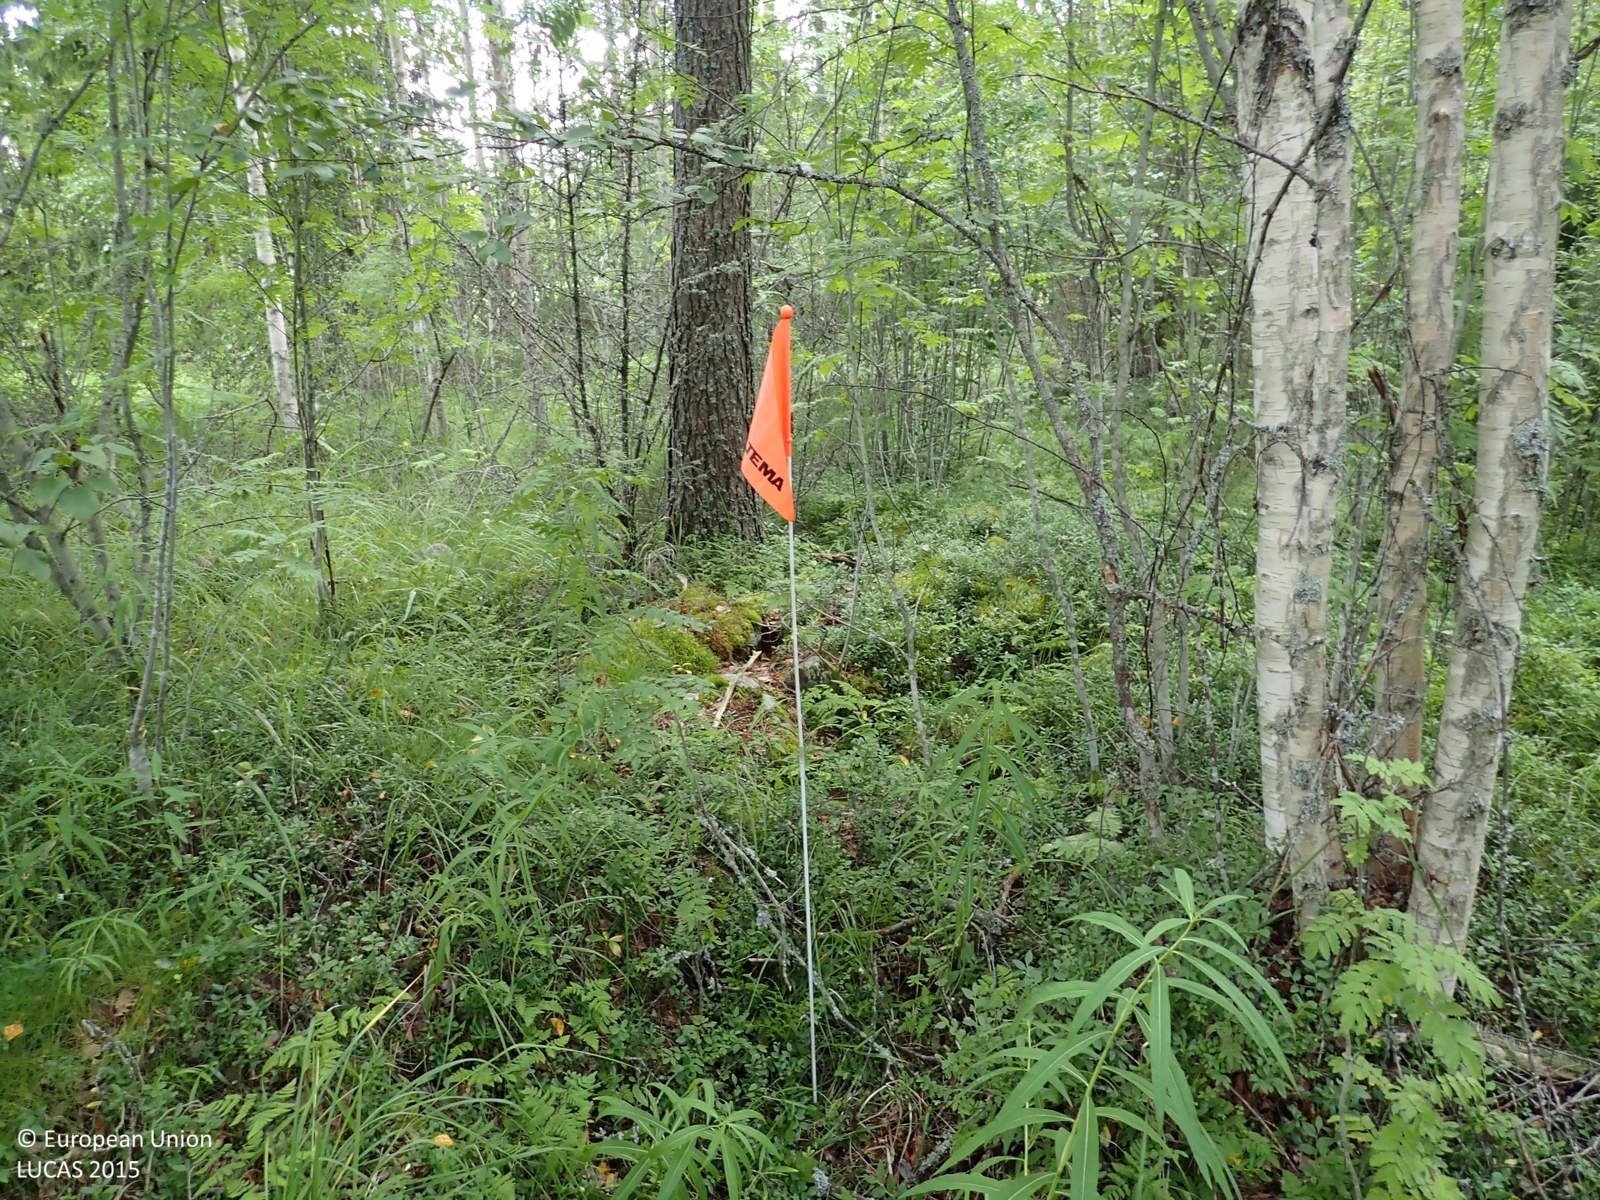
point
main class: Woodland
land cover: Pine dominated mixed woodland
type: boreal forest
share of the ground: > 75 %
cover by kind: coniferous forest trees 60 %, broadleaved forest trees 20 %, shrubs 15 %, herbaceous plants 5 %
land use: Forestry
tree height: > 5 m
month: August
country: FI
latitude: 62.6719
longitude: 21.8587
